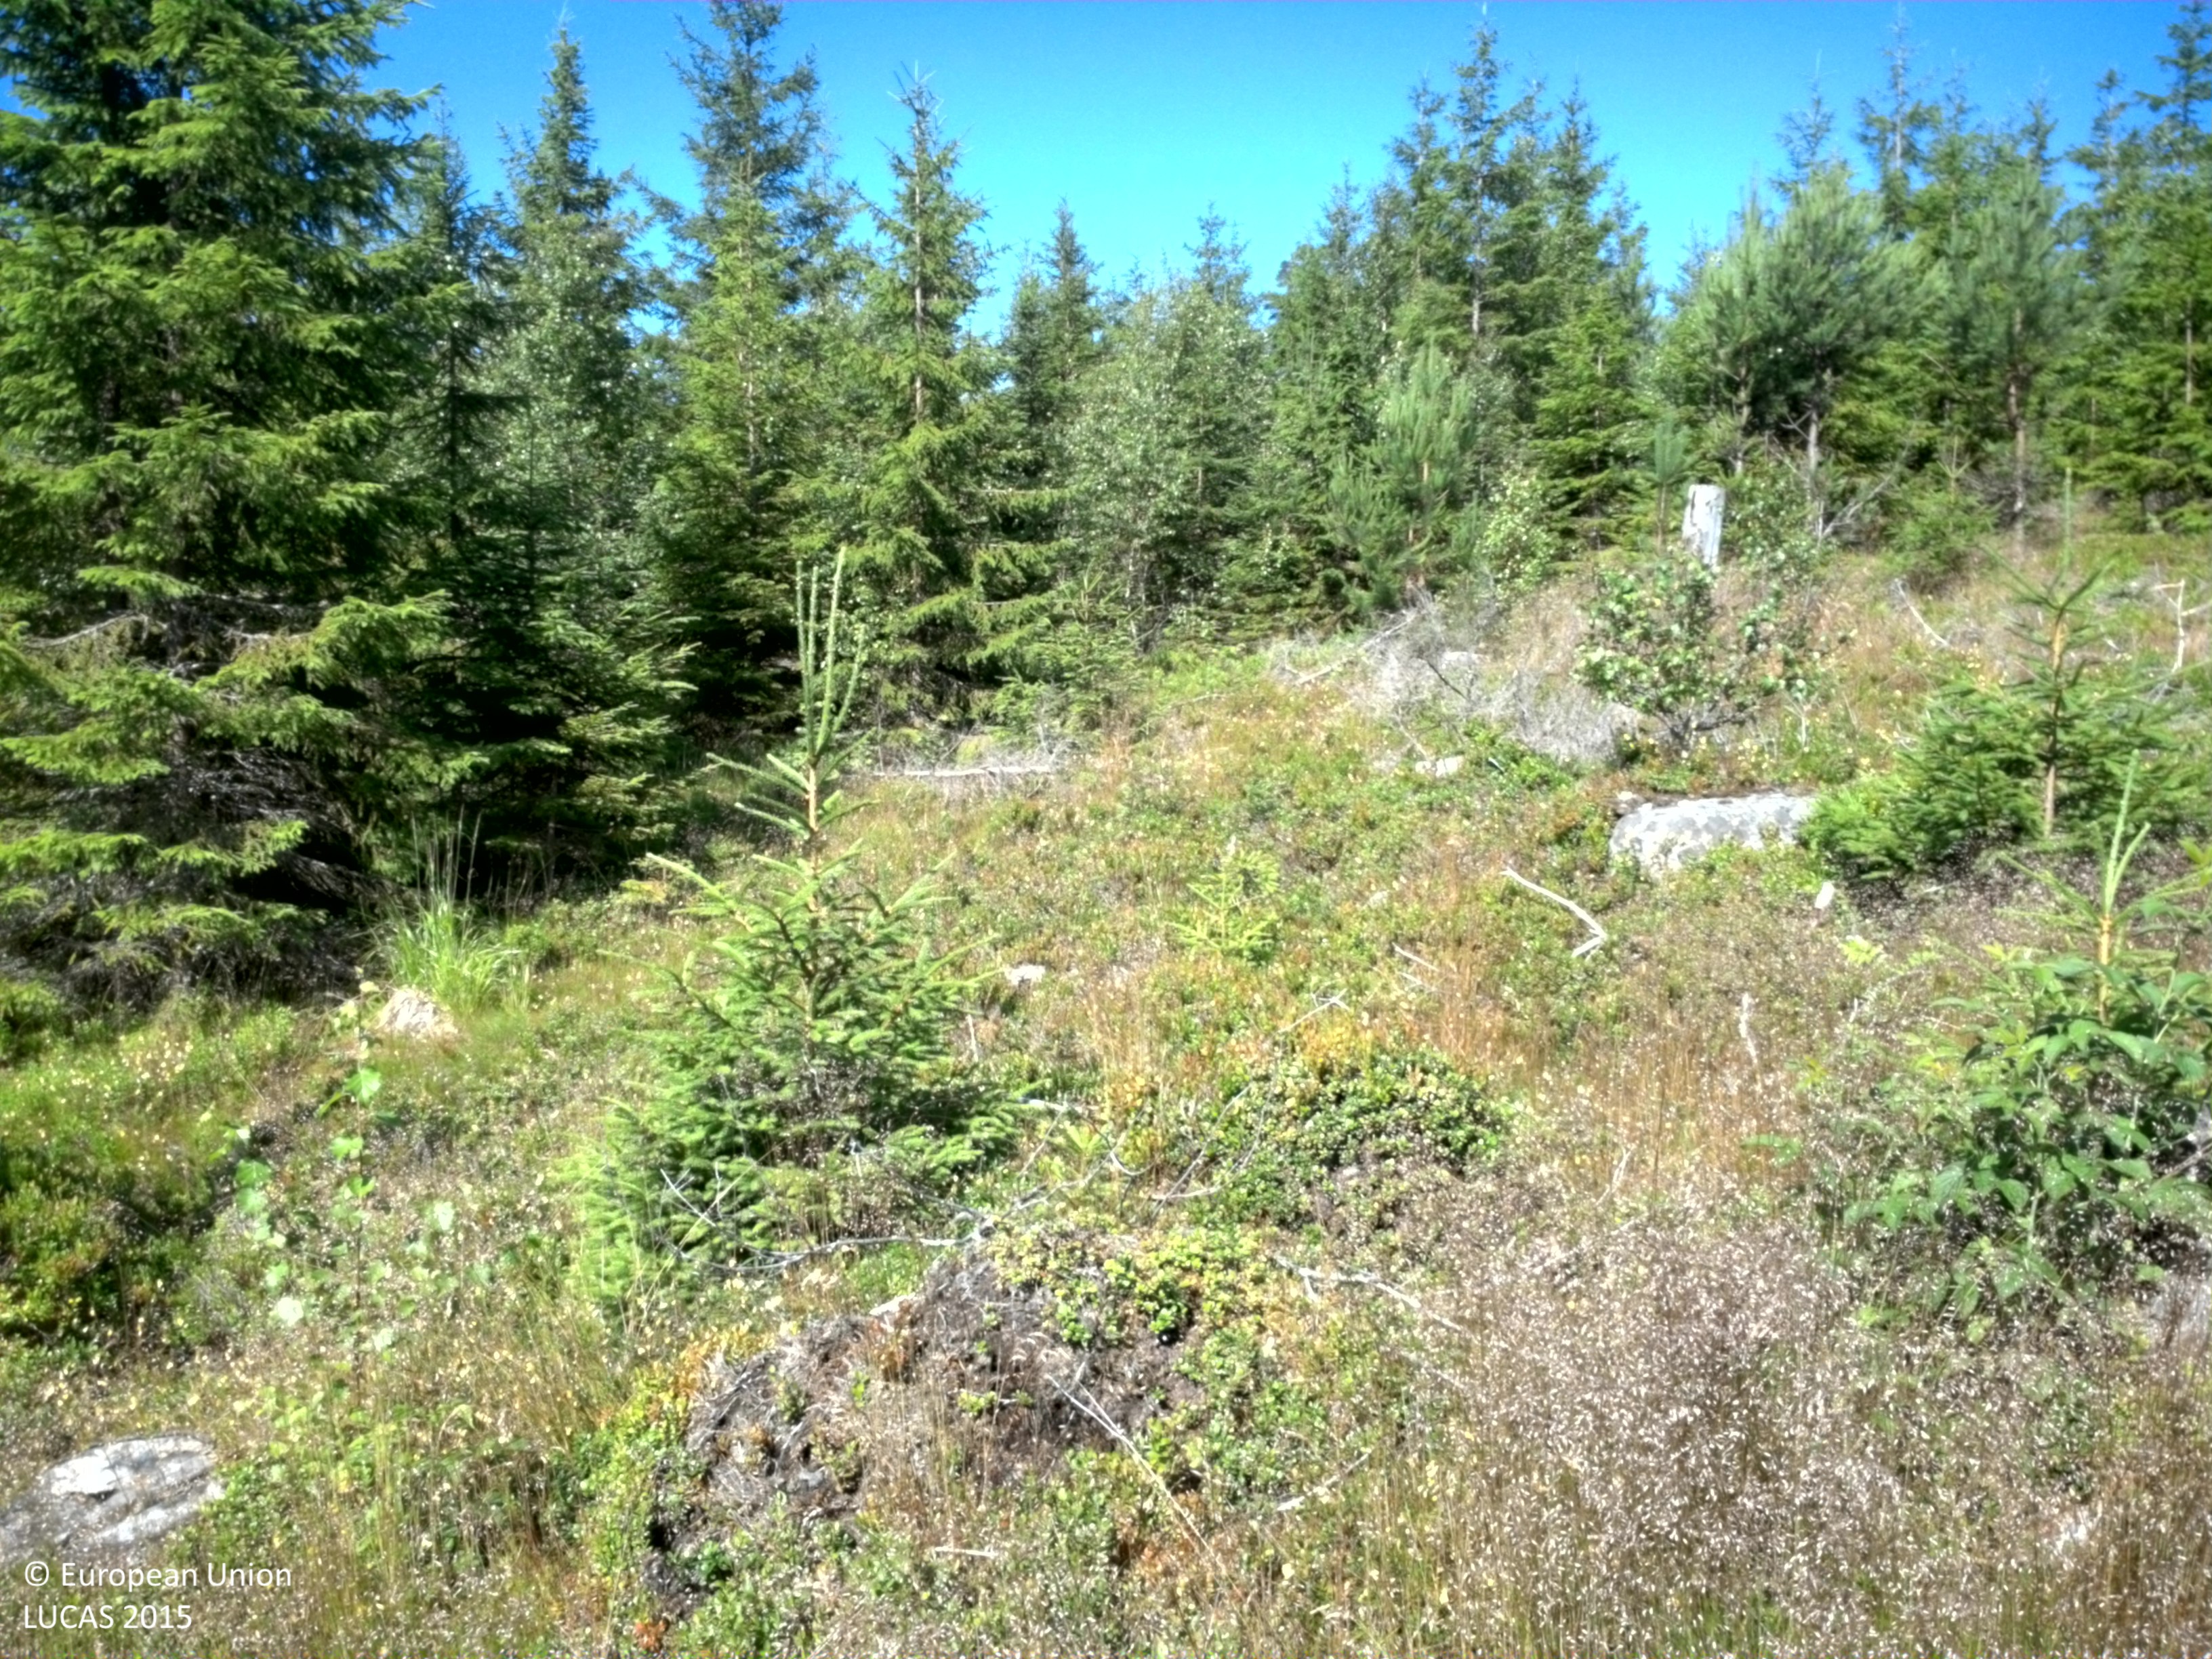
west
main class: Woodland
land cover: Spruce dominated coniferous woodland
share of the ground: 10 - 25 %
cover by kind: shrubs 45 %, herbaceous plants 40 %, coniferous forest trees 15 %
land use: Forestry
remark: Clear cut
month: July
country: SE
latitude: 59.7149
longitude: 14.4170
